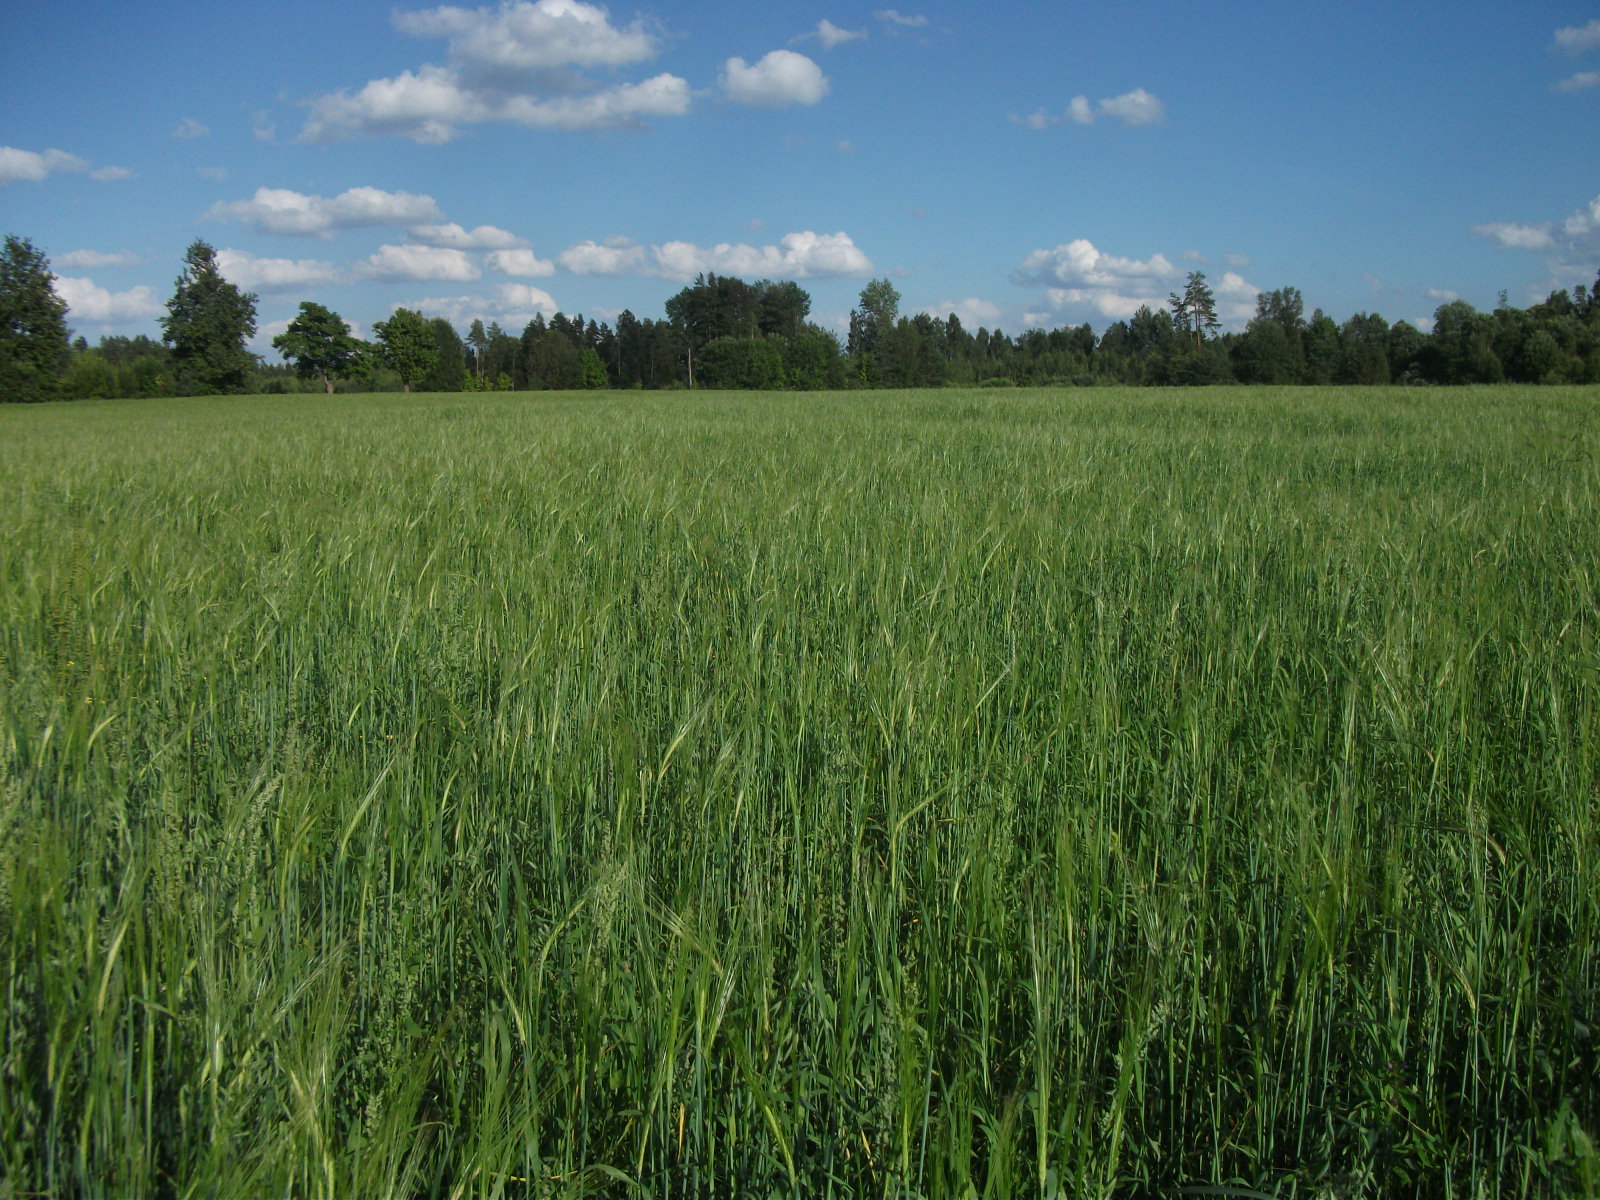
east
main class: Cropland
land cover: Barley
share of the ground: > 75 %
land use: Agriculture (excluding fallow land and kitchen gardens)
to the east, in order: Barley; Lines of trees; Tracks; Abandoned hedges; Oats
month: August
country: LV
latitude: 57.0449
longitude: 26.6146
